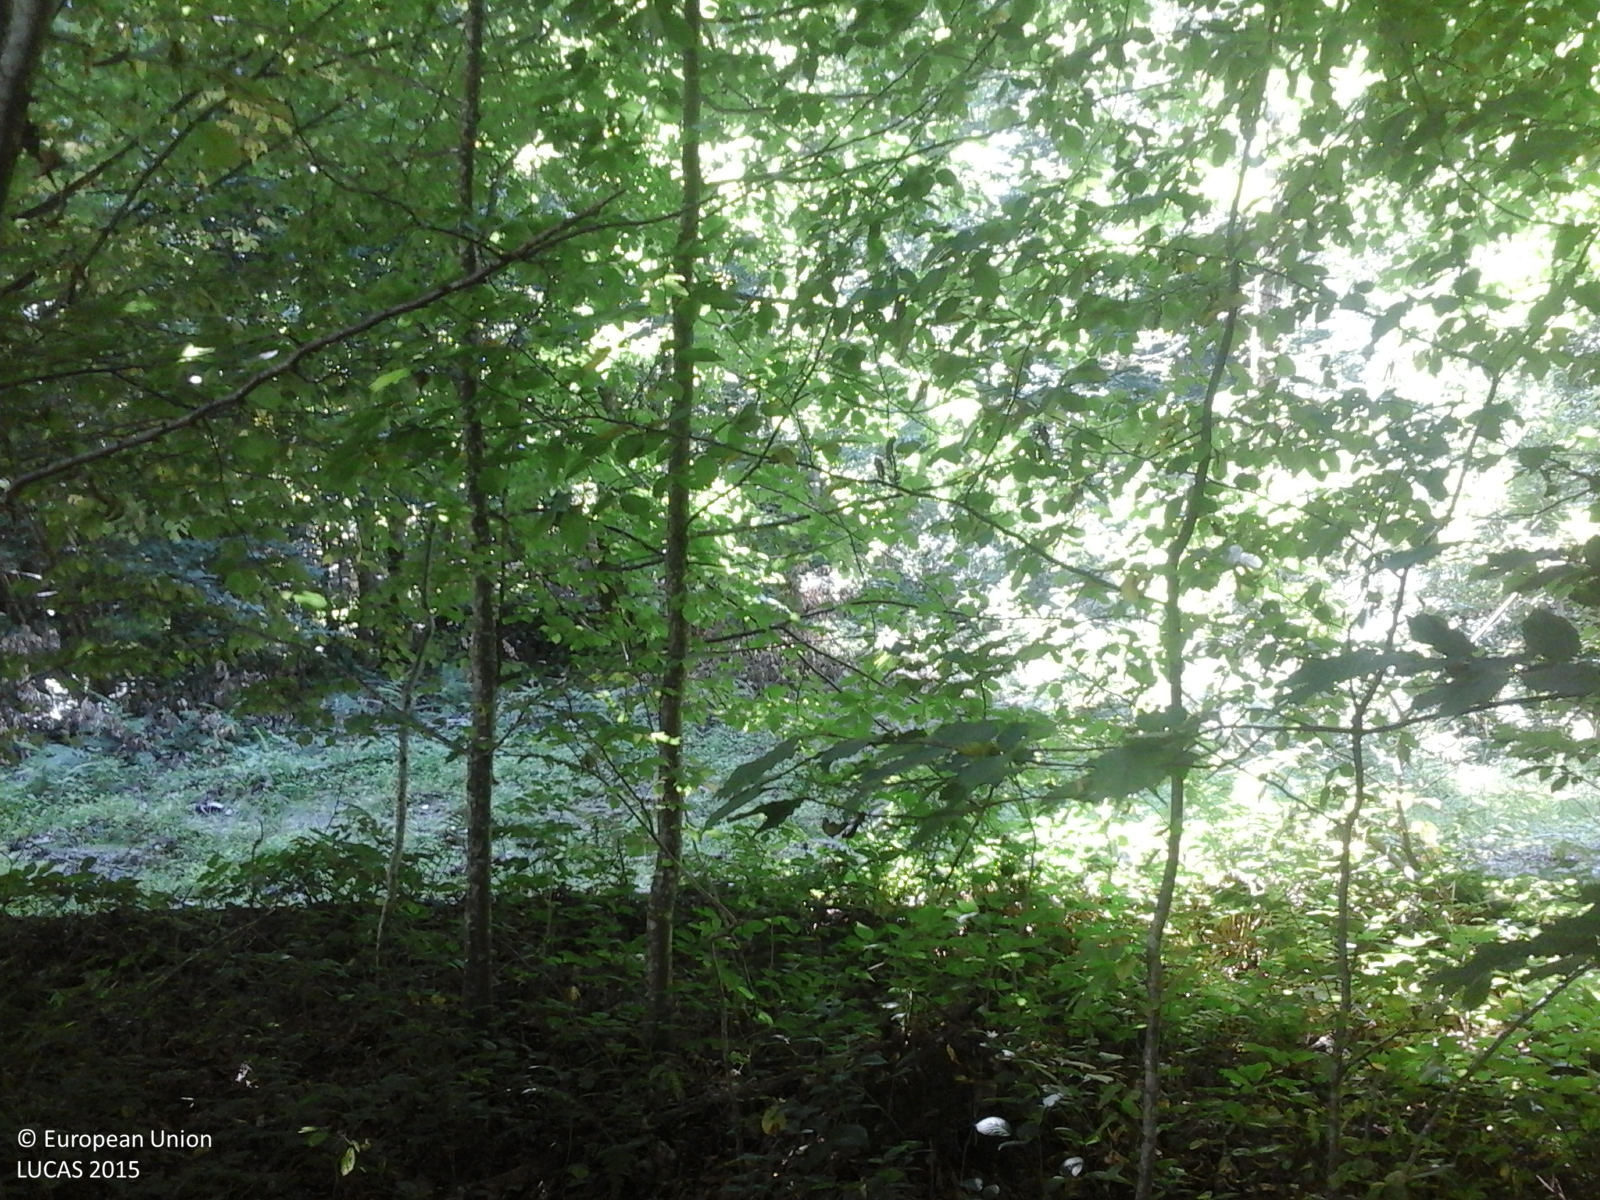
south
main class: Woodland
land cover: Broadleaved woodland
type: non-riverine alder, birch or aspen forest
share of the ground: > 75 %
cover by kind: broadleaved forest trees 100 %
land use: Forestry
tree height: > 5 m
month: August
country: RO
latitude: 46.4724
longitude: 22.3301
